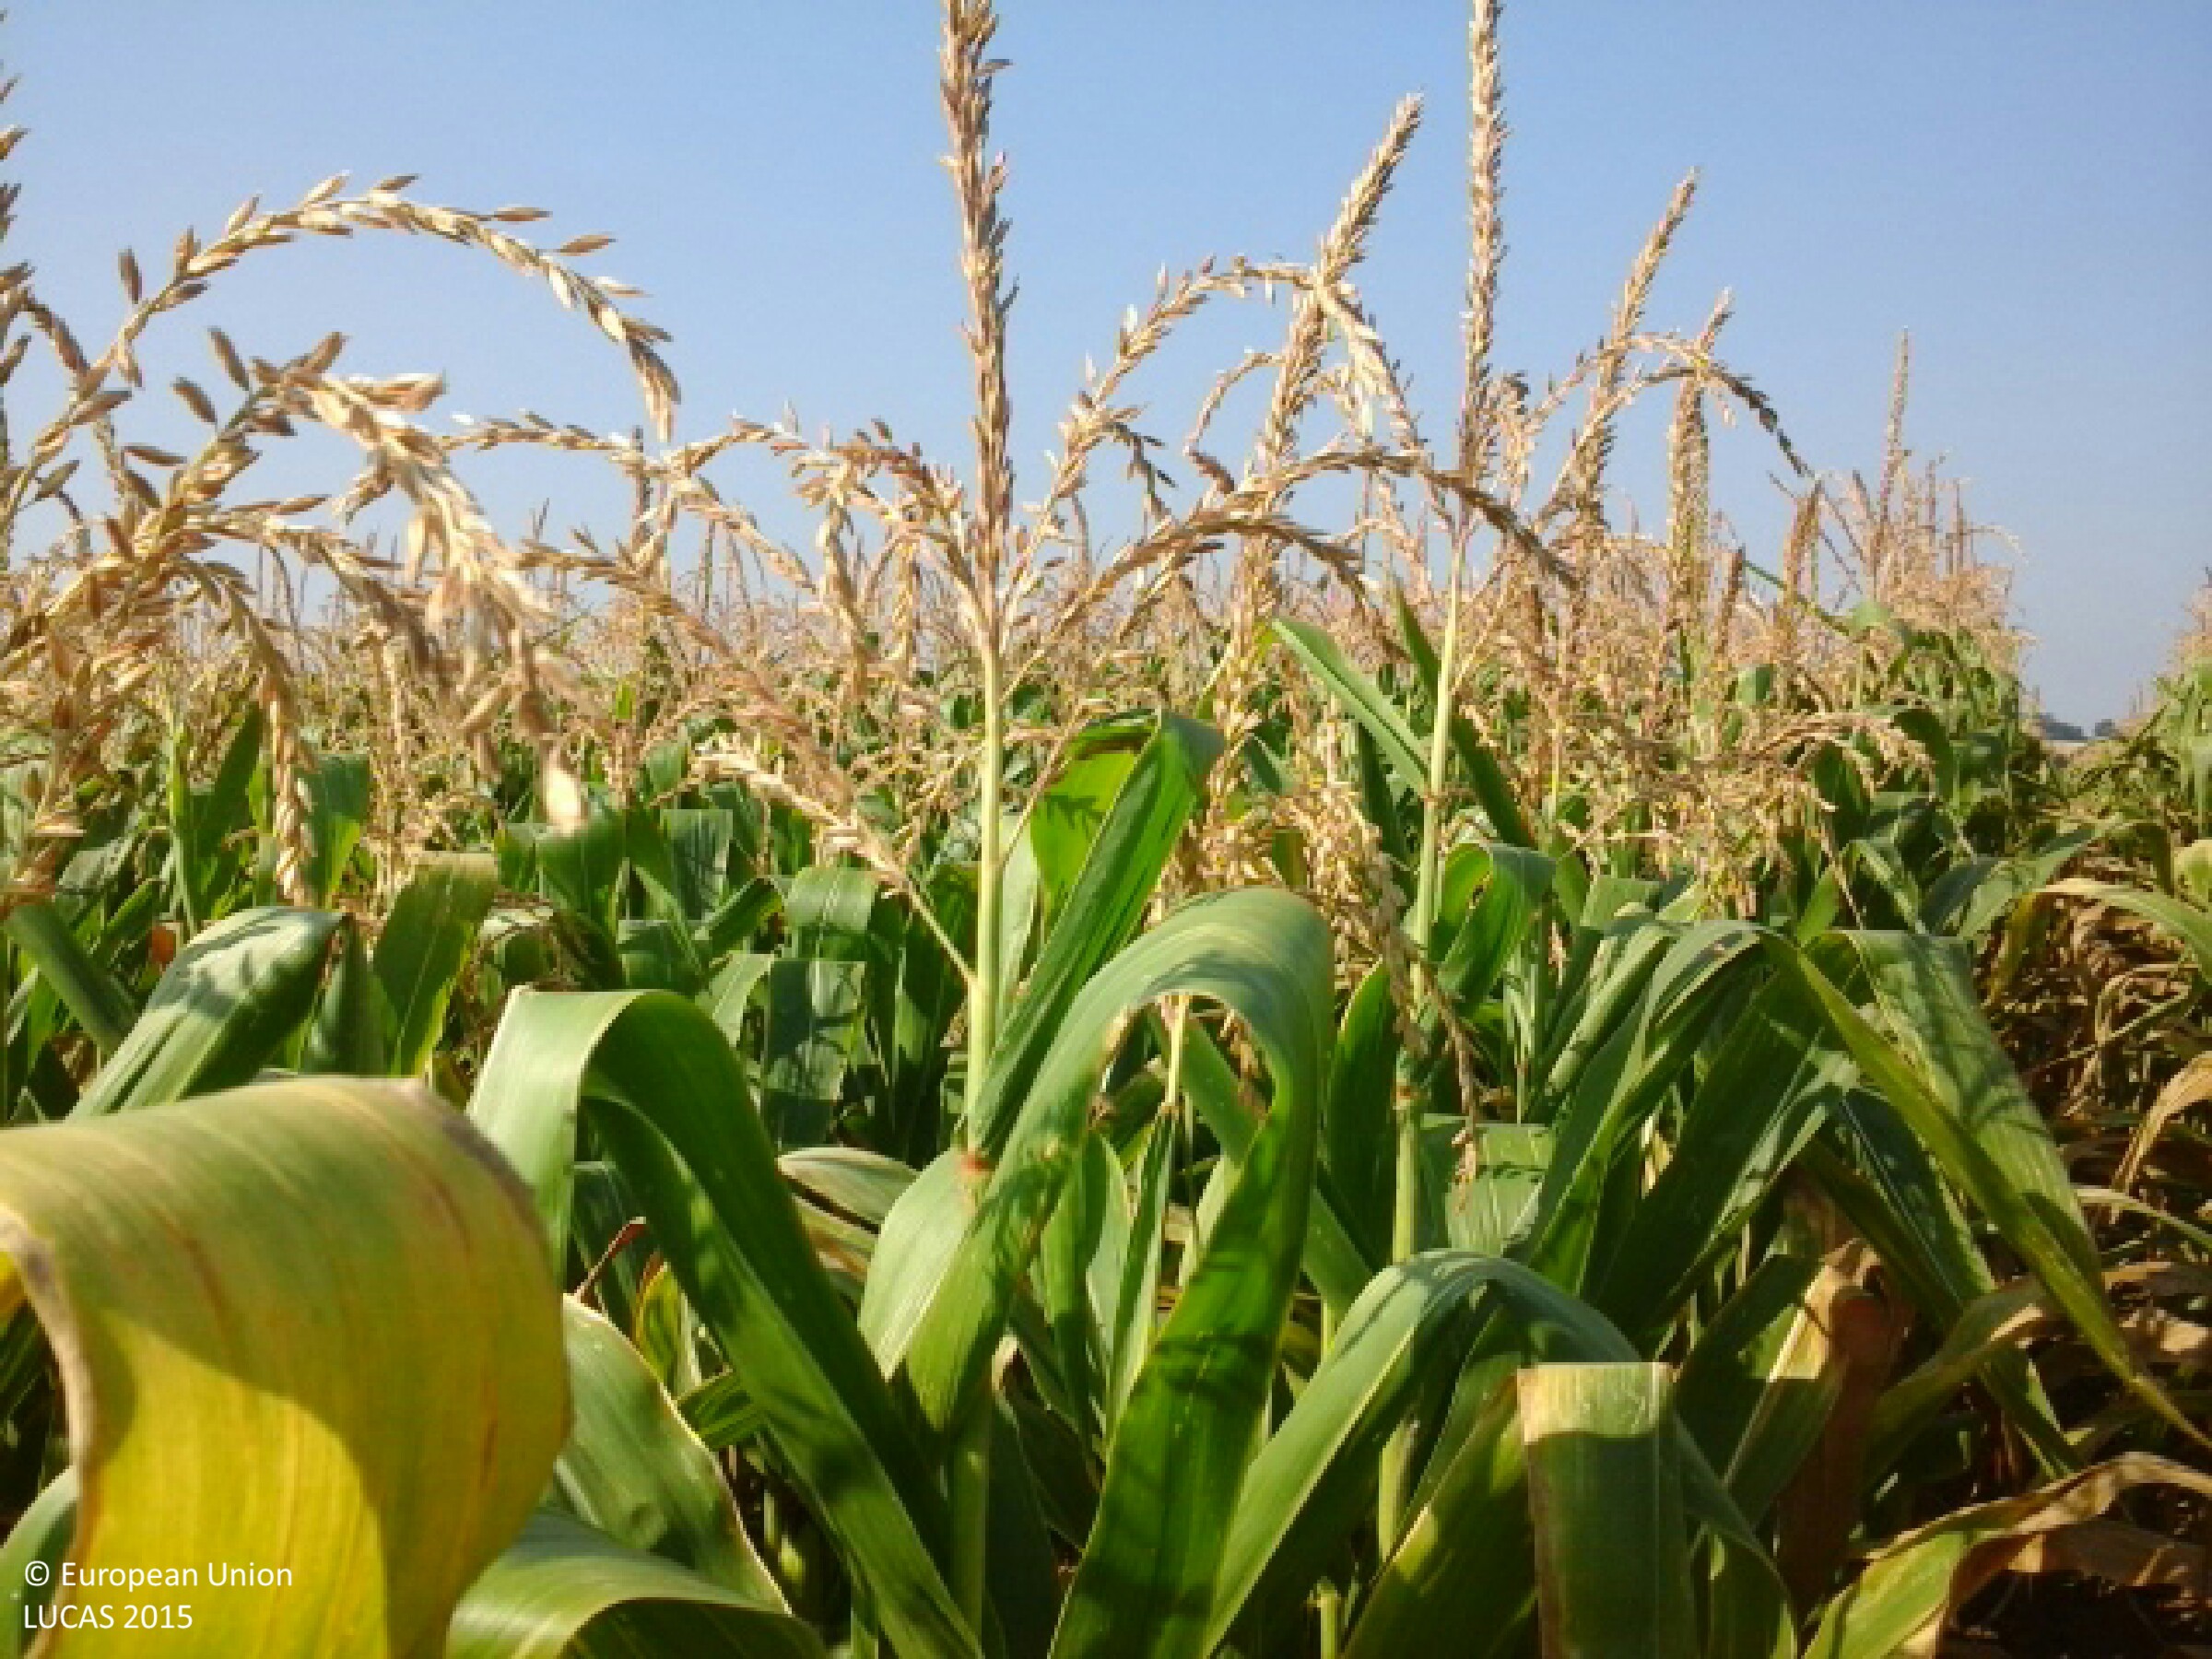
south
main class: Cropland
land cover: Maize
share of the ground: > 75 %
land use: Agriculture (excluding fallow land and kitchen gardens)
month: August
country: HU
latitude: 47.6623
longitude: 18.2287
